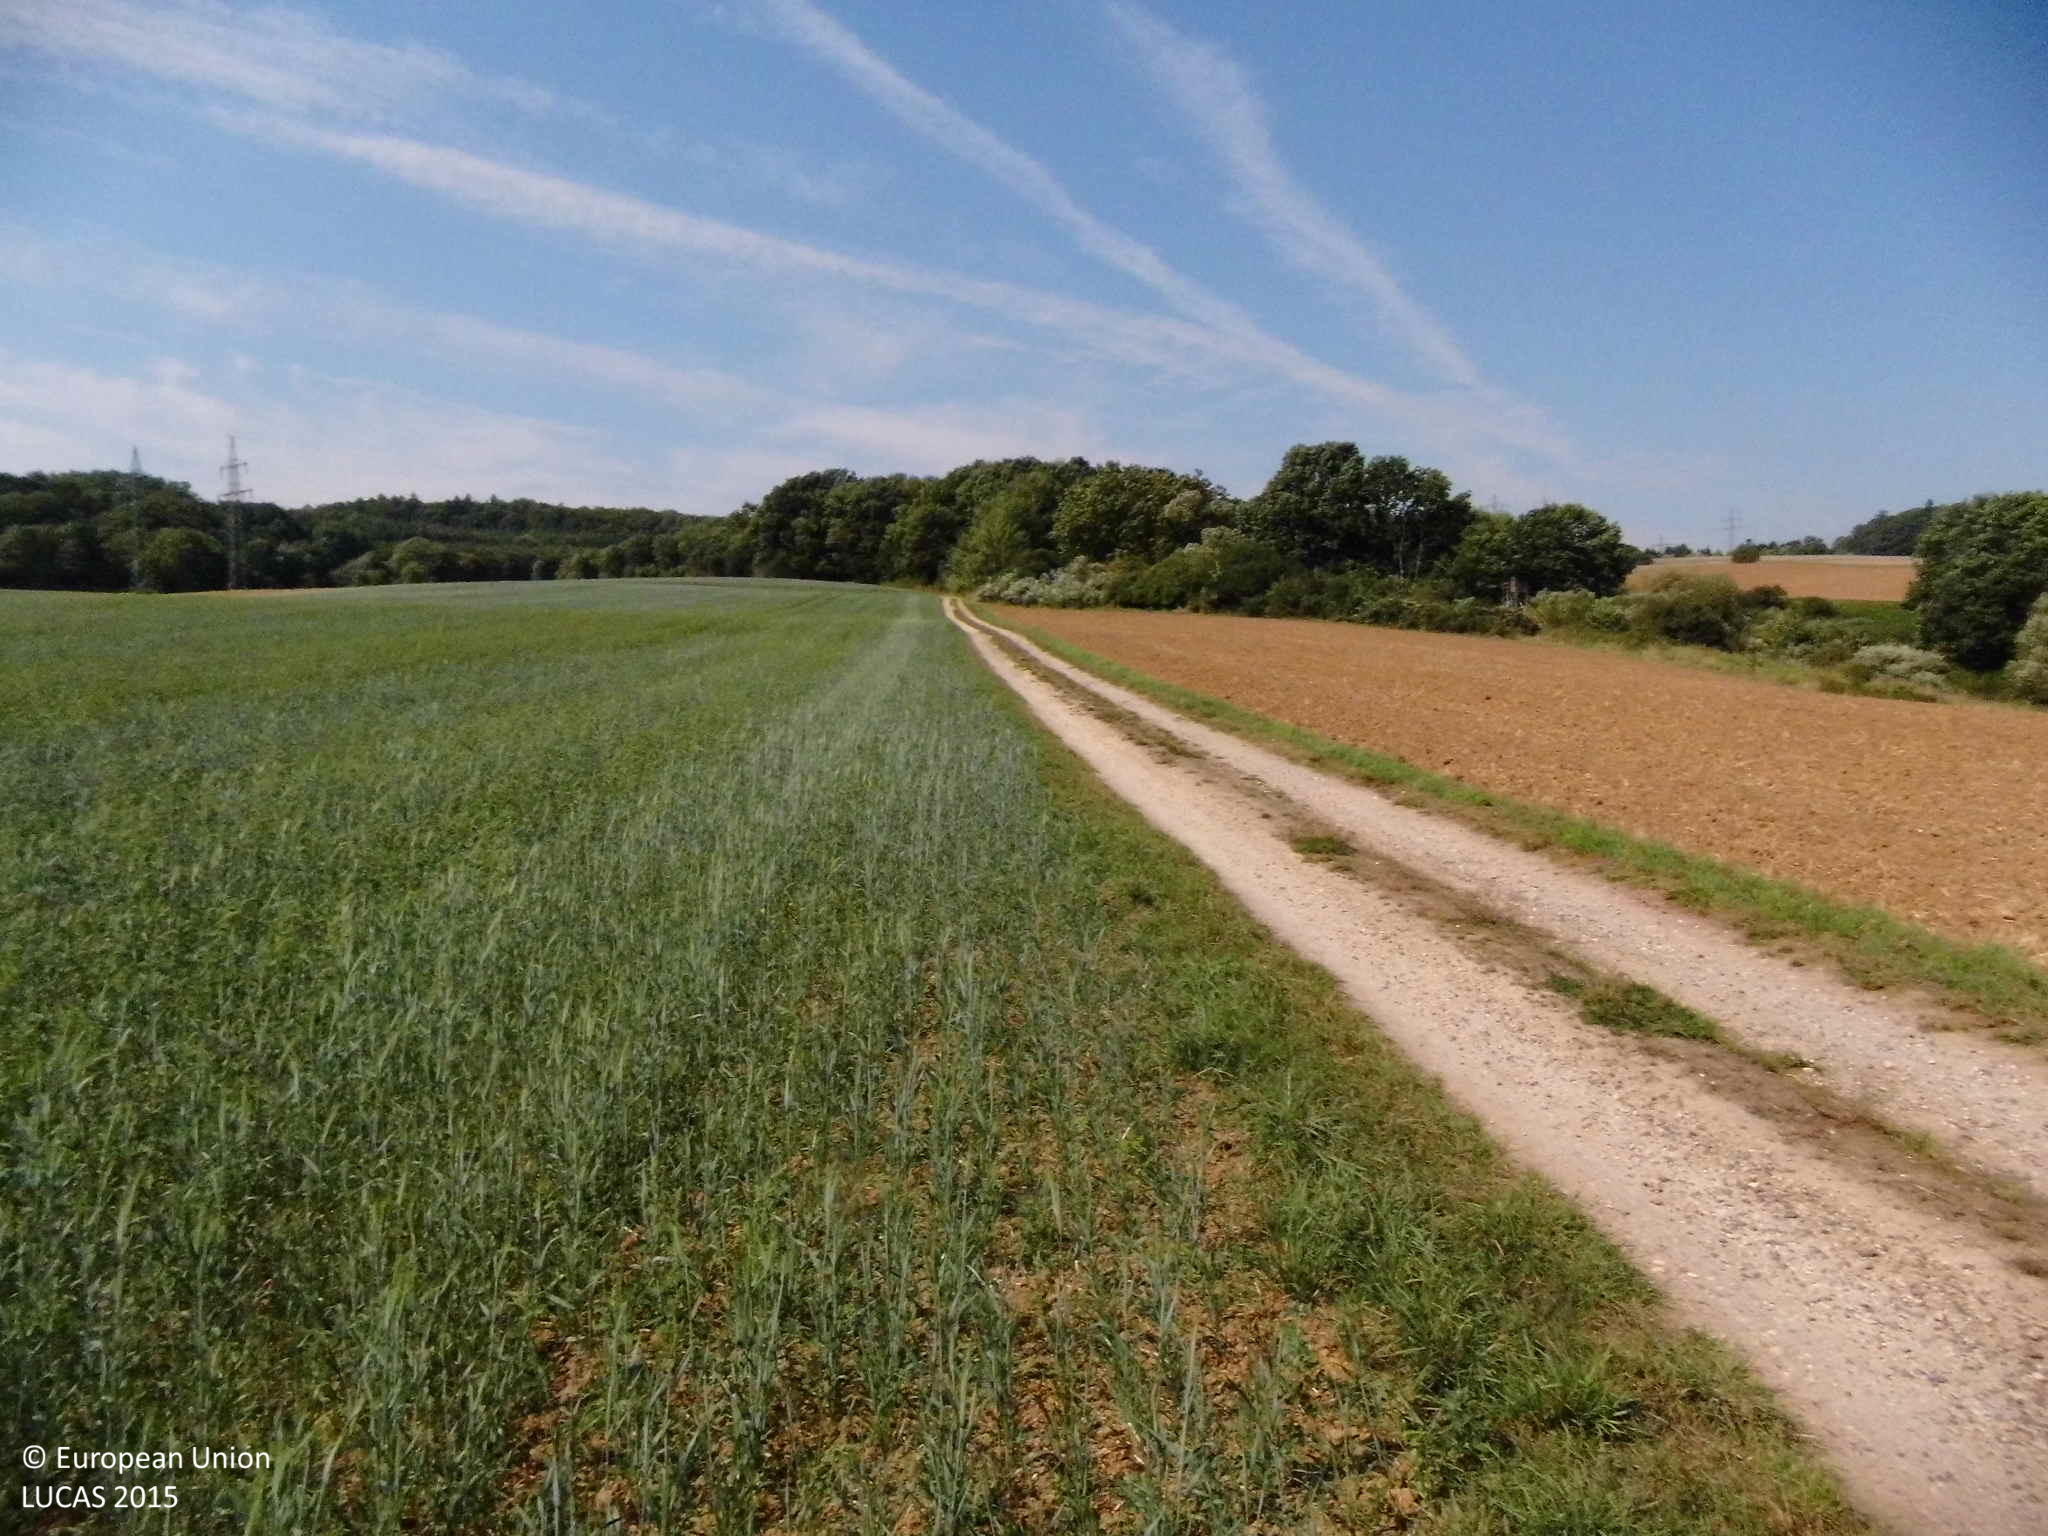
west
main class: Cropland
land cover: Rye
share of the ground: 25 - 50 %
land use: Agriculture (excluding fallow land and kitchen gardens)
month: August
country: DE
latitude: 50.4368
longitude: 8.0152
